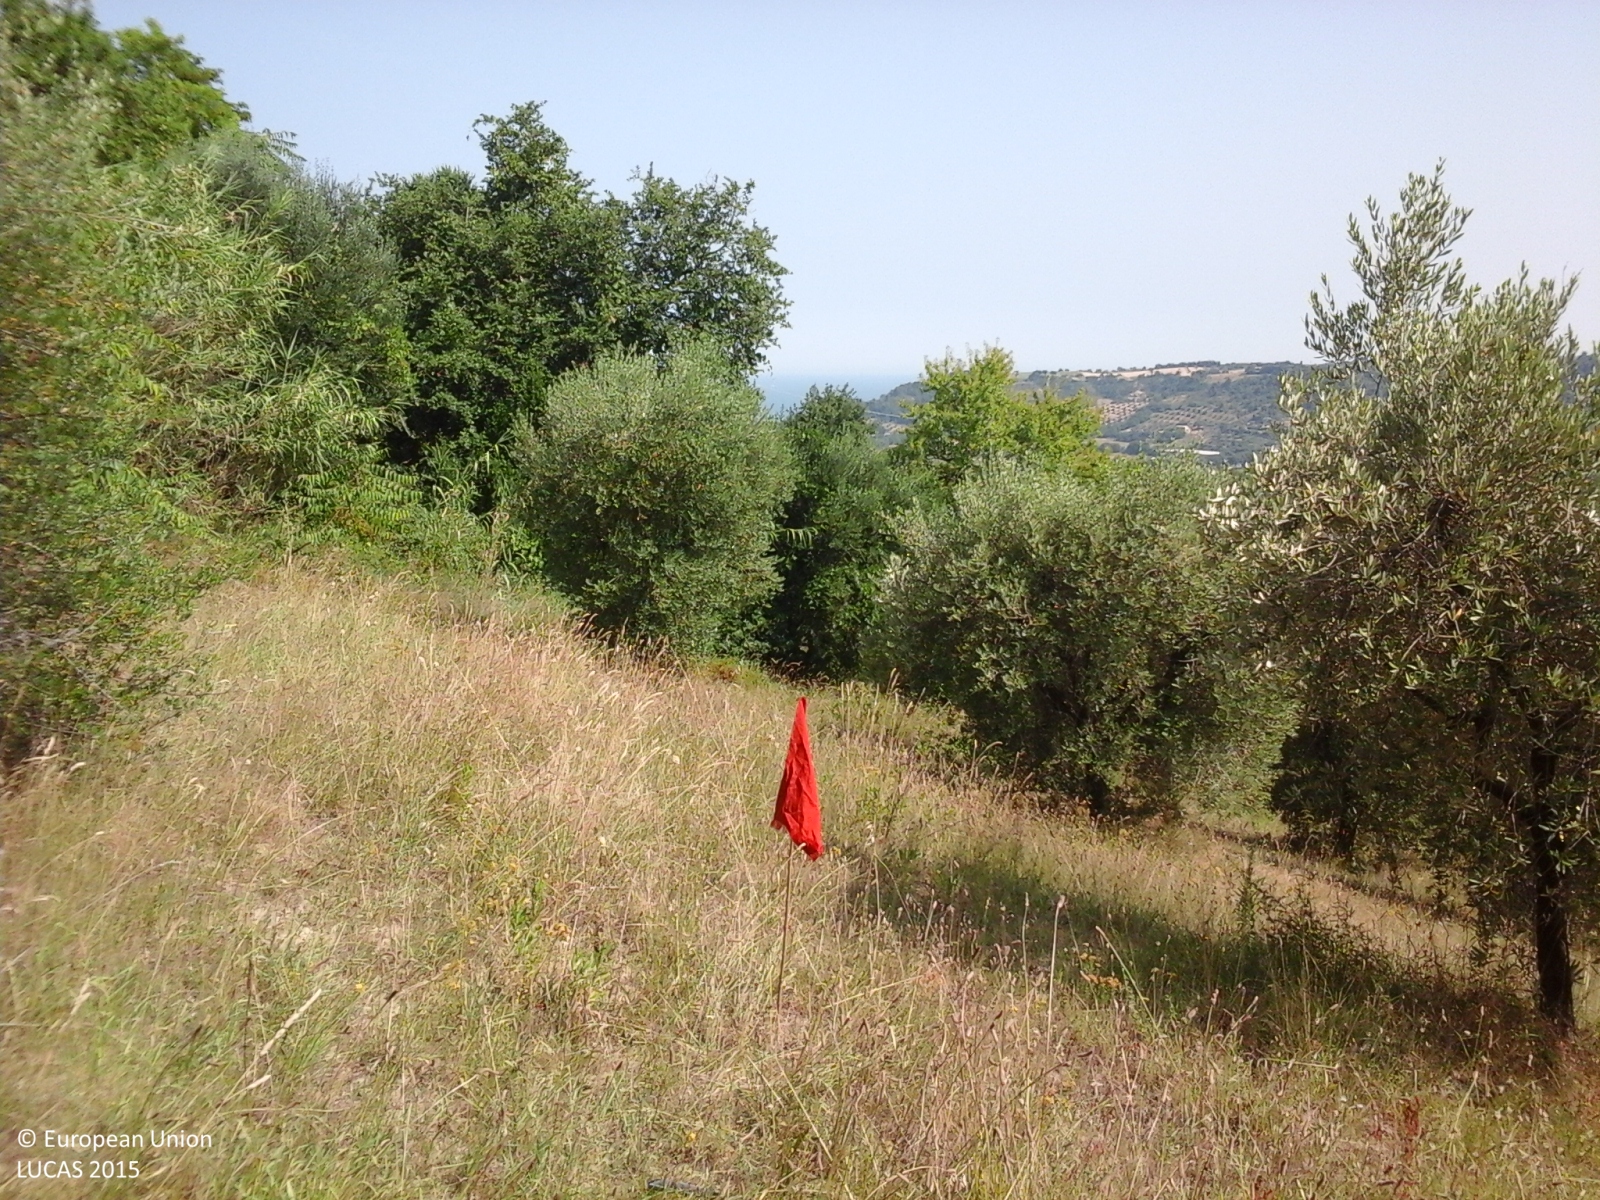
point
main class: Cropland
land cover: Olive groves
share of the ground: 10 - 25 %
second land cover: Grassland without tree/shrub cover
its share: 50 - 75 %
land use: Agriculture (excluding fallow land and kitchen gardens)
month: July
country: IT
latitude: 43.0515
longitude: 13.8326
